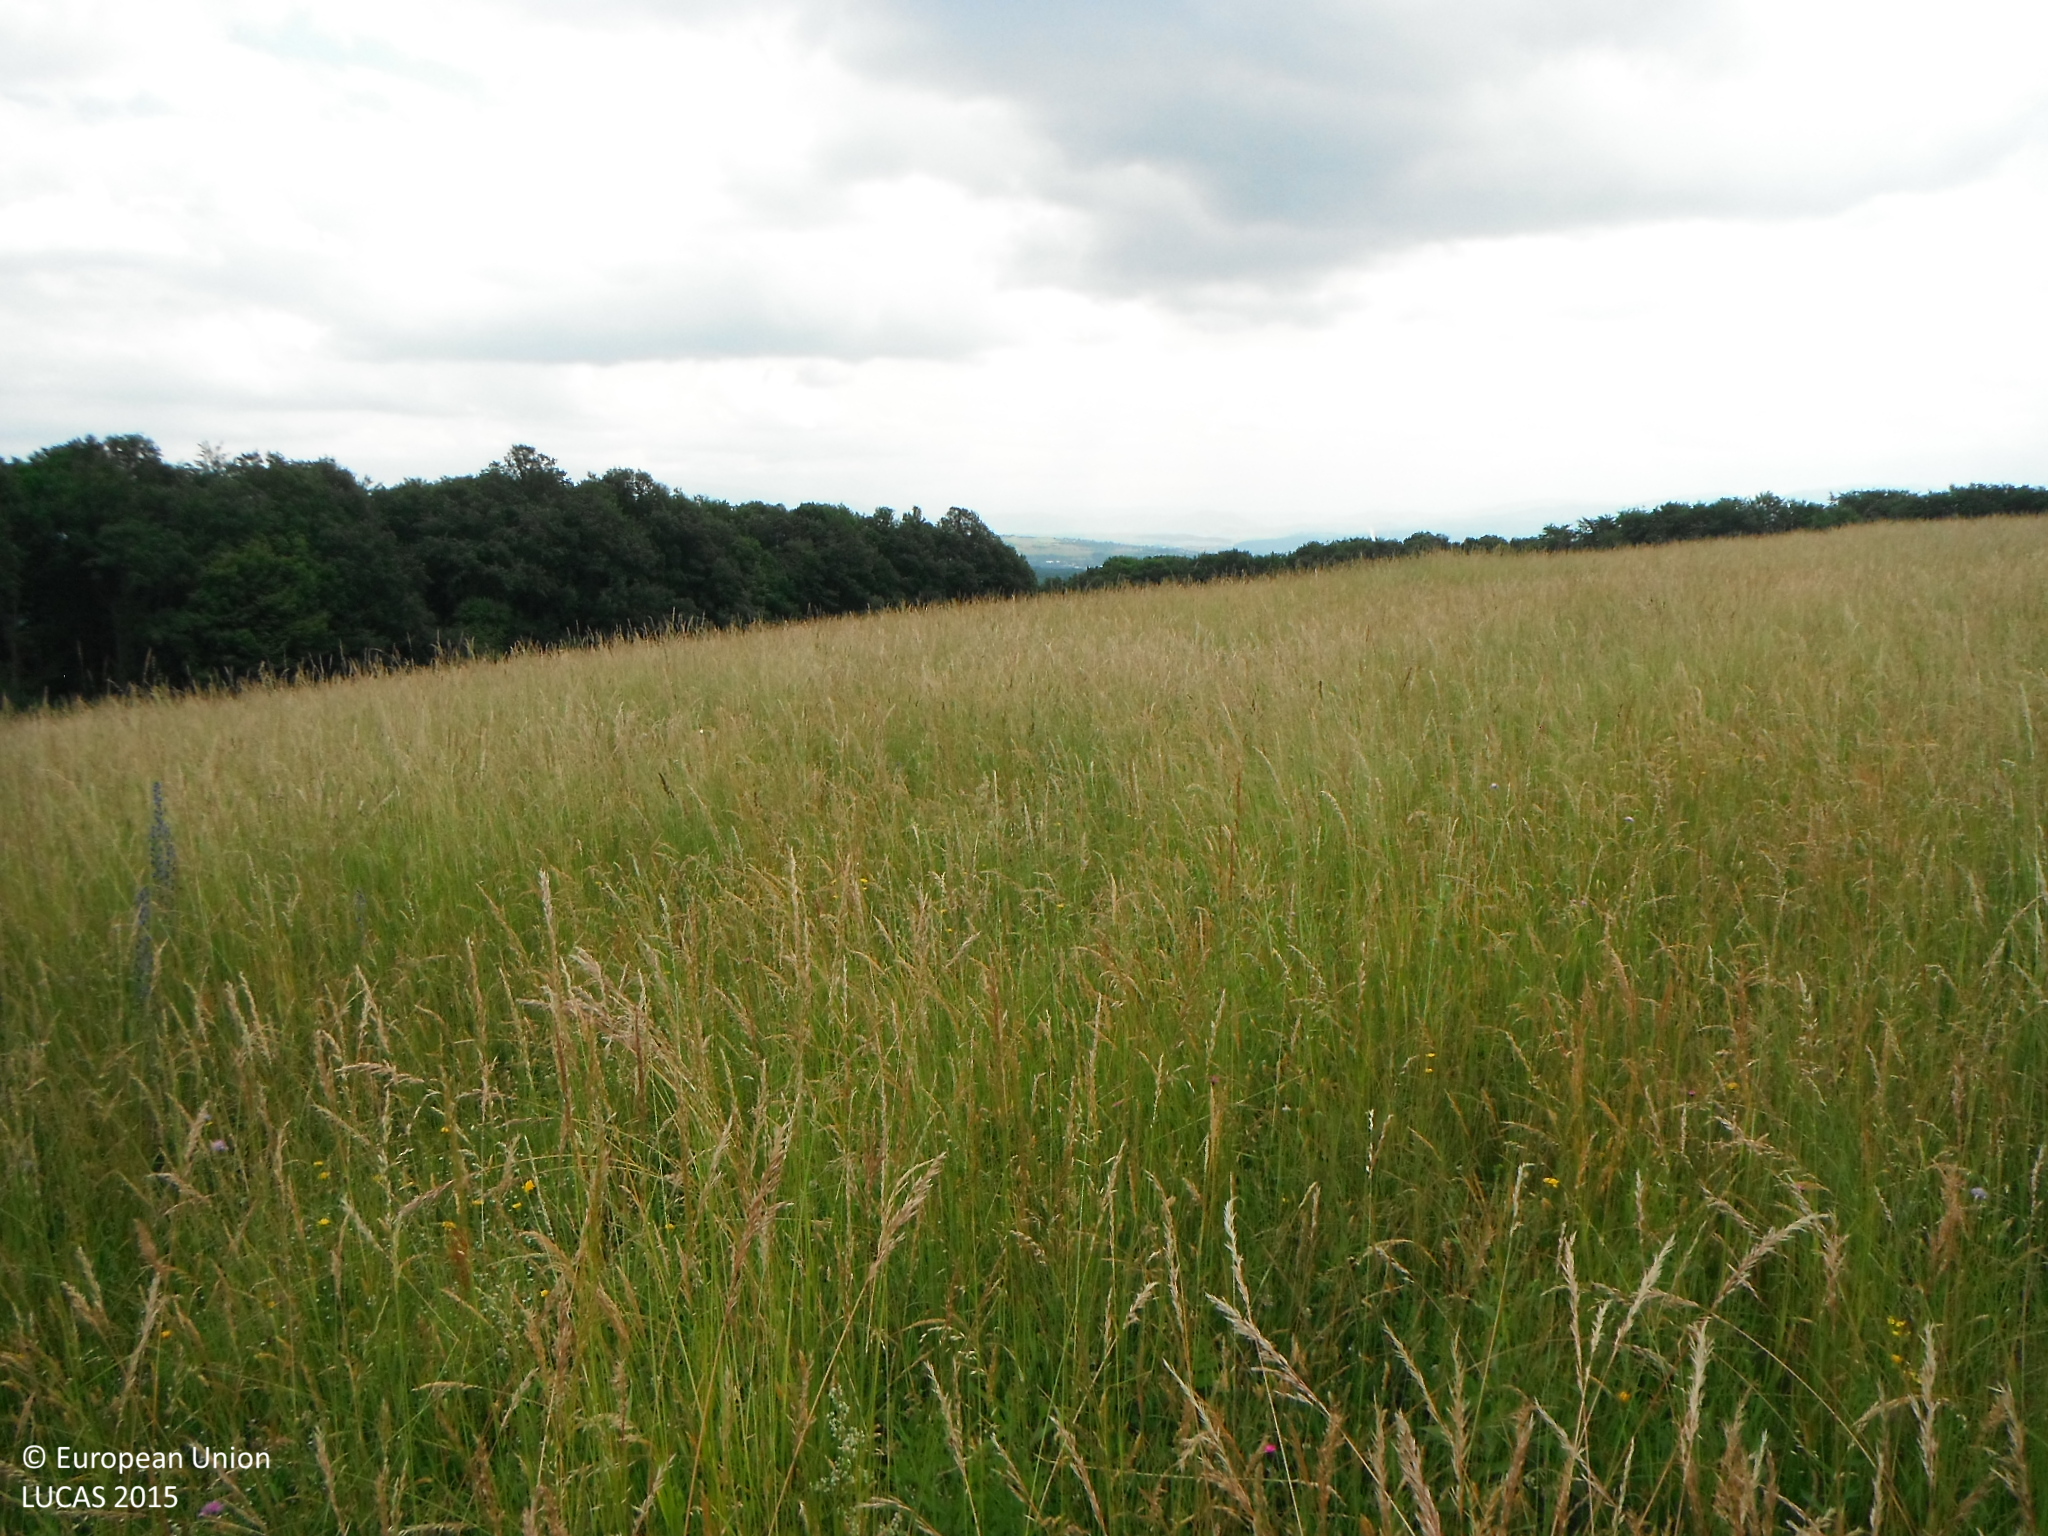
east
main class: Grassland
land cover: Grassland without tree/shrub cover
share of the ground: > 75 %
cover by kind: herbaceous plants 100 %
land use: Agriculture (excluding fallow land and kitchen gardens)
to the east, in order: Grassland without tree/shrub cover; Broadleaved woodland
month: June
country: SK
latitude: 48.5939
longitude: 19.0377
